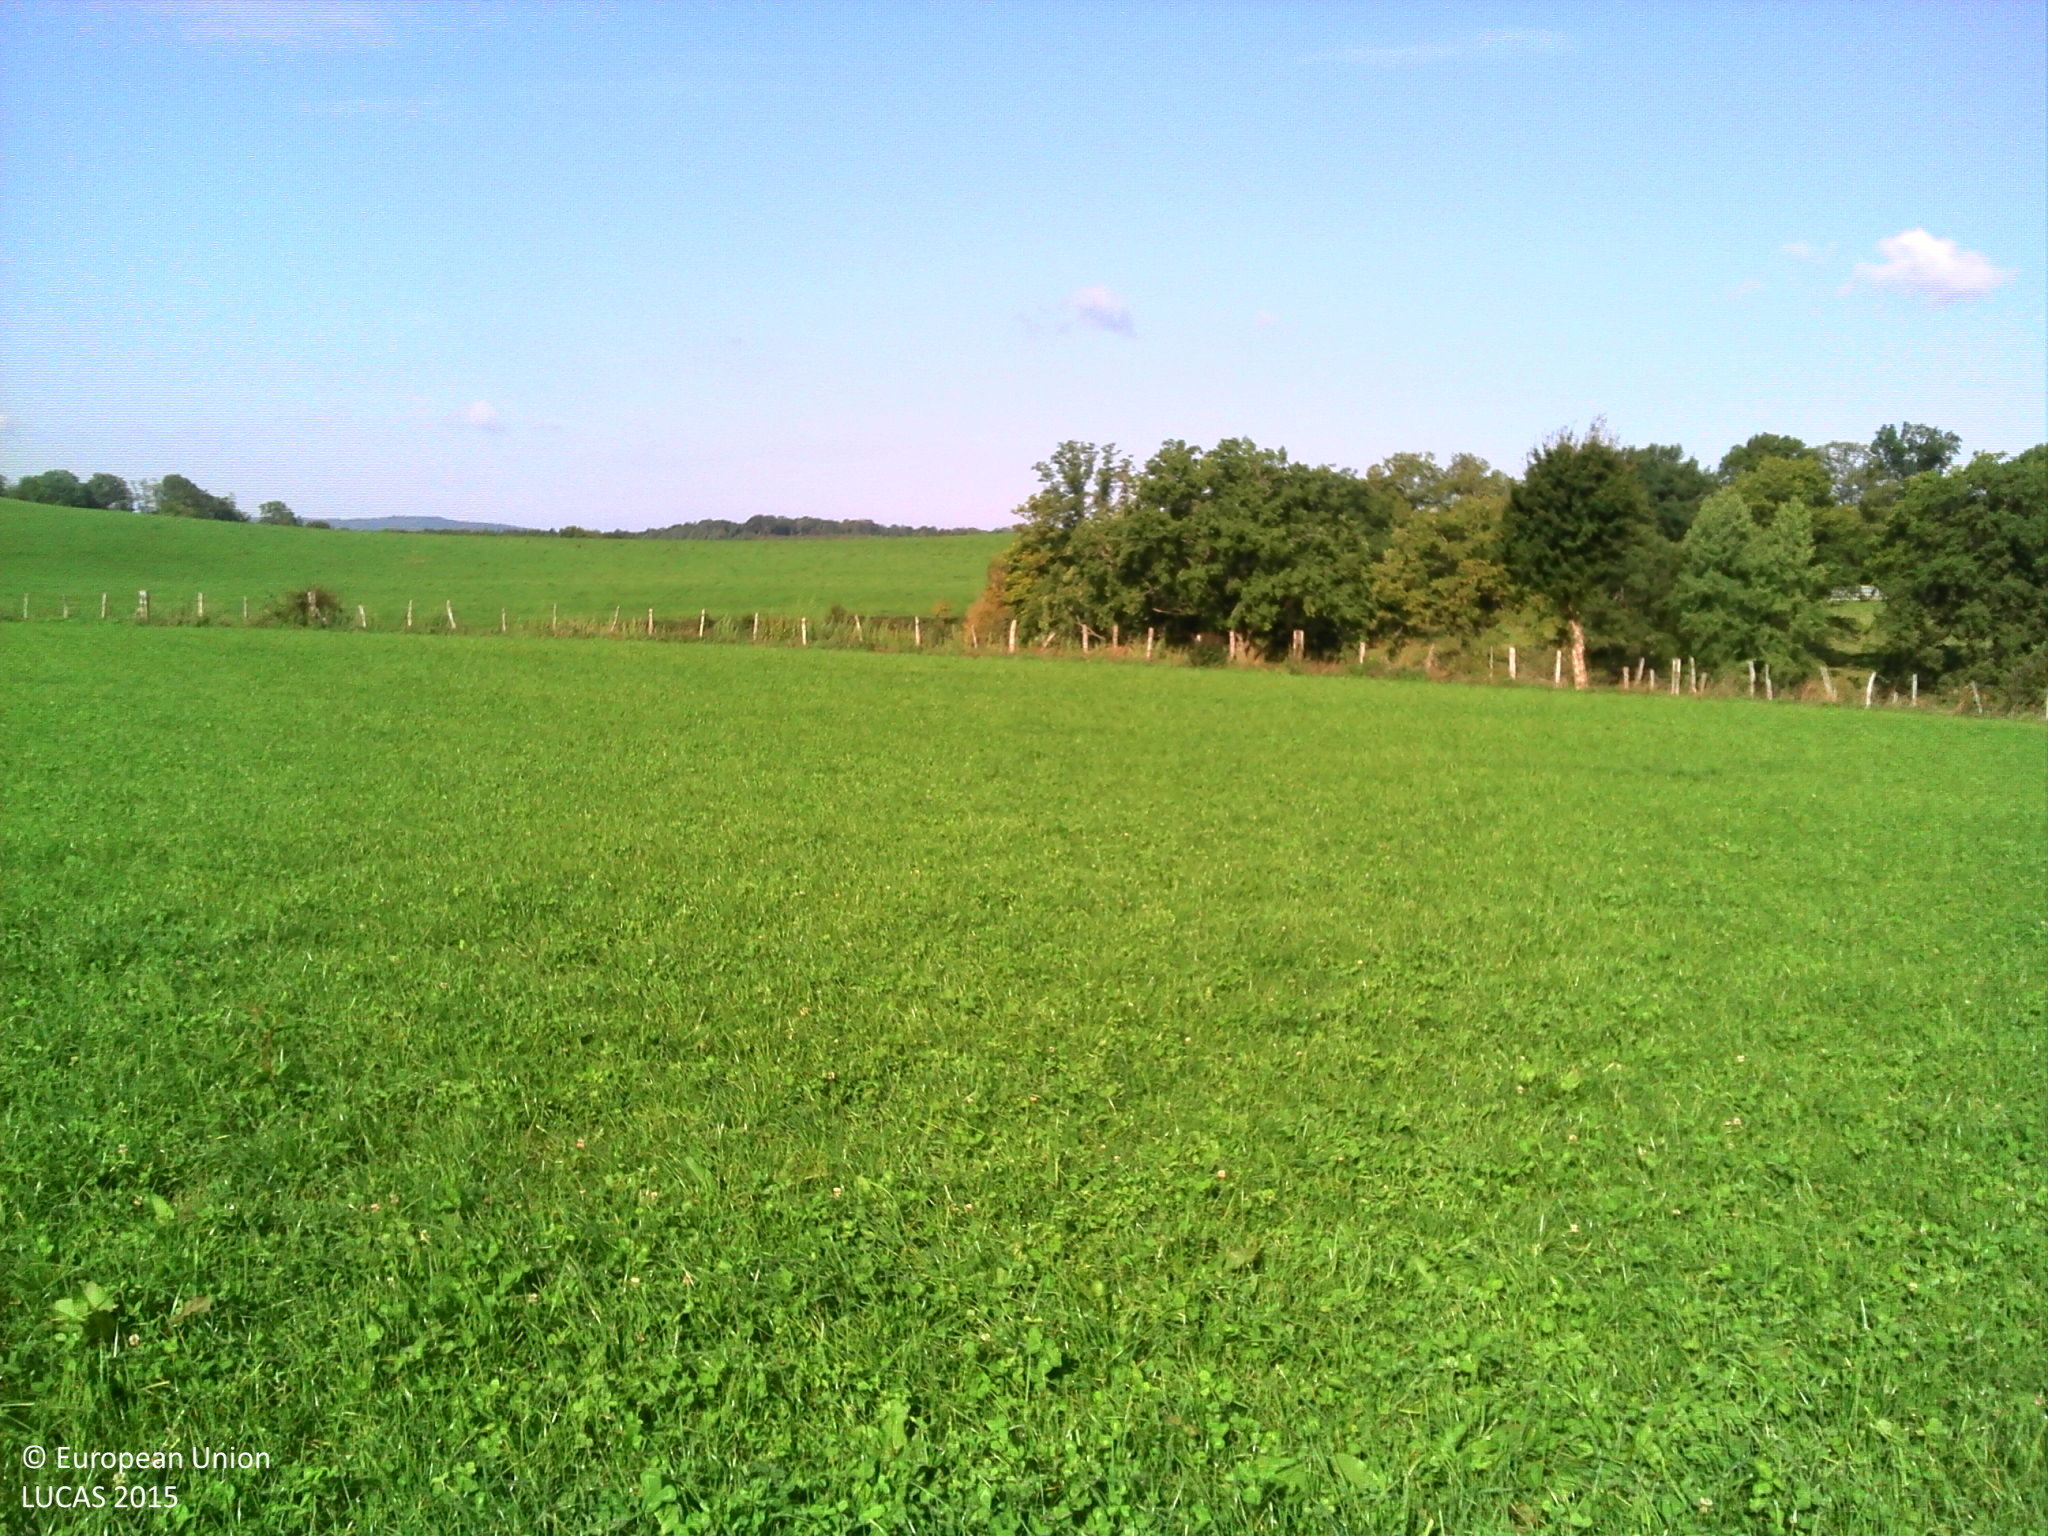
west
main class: Grassland
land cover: Grassland without tree/shrub cover
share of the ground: > 75 %
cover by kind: herbaceous plants 100 %
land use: Agriculture (excluding fallow land and kitchen gardens)
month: September
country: FR
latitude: 47.2090
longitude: 6.3712
